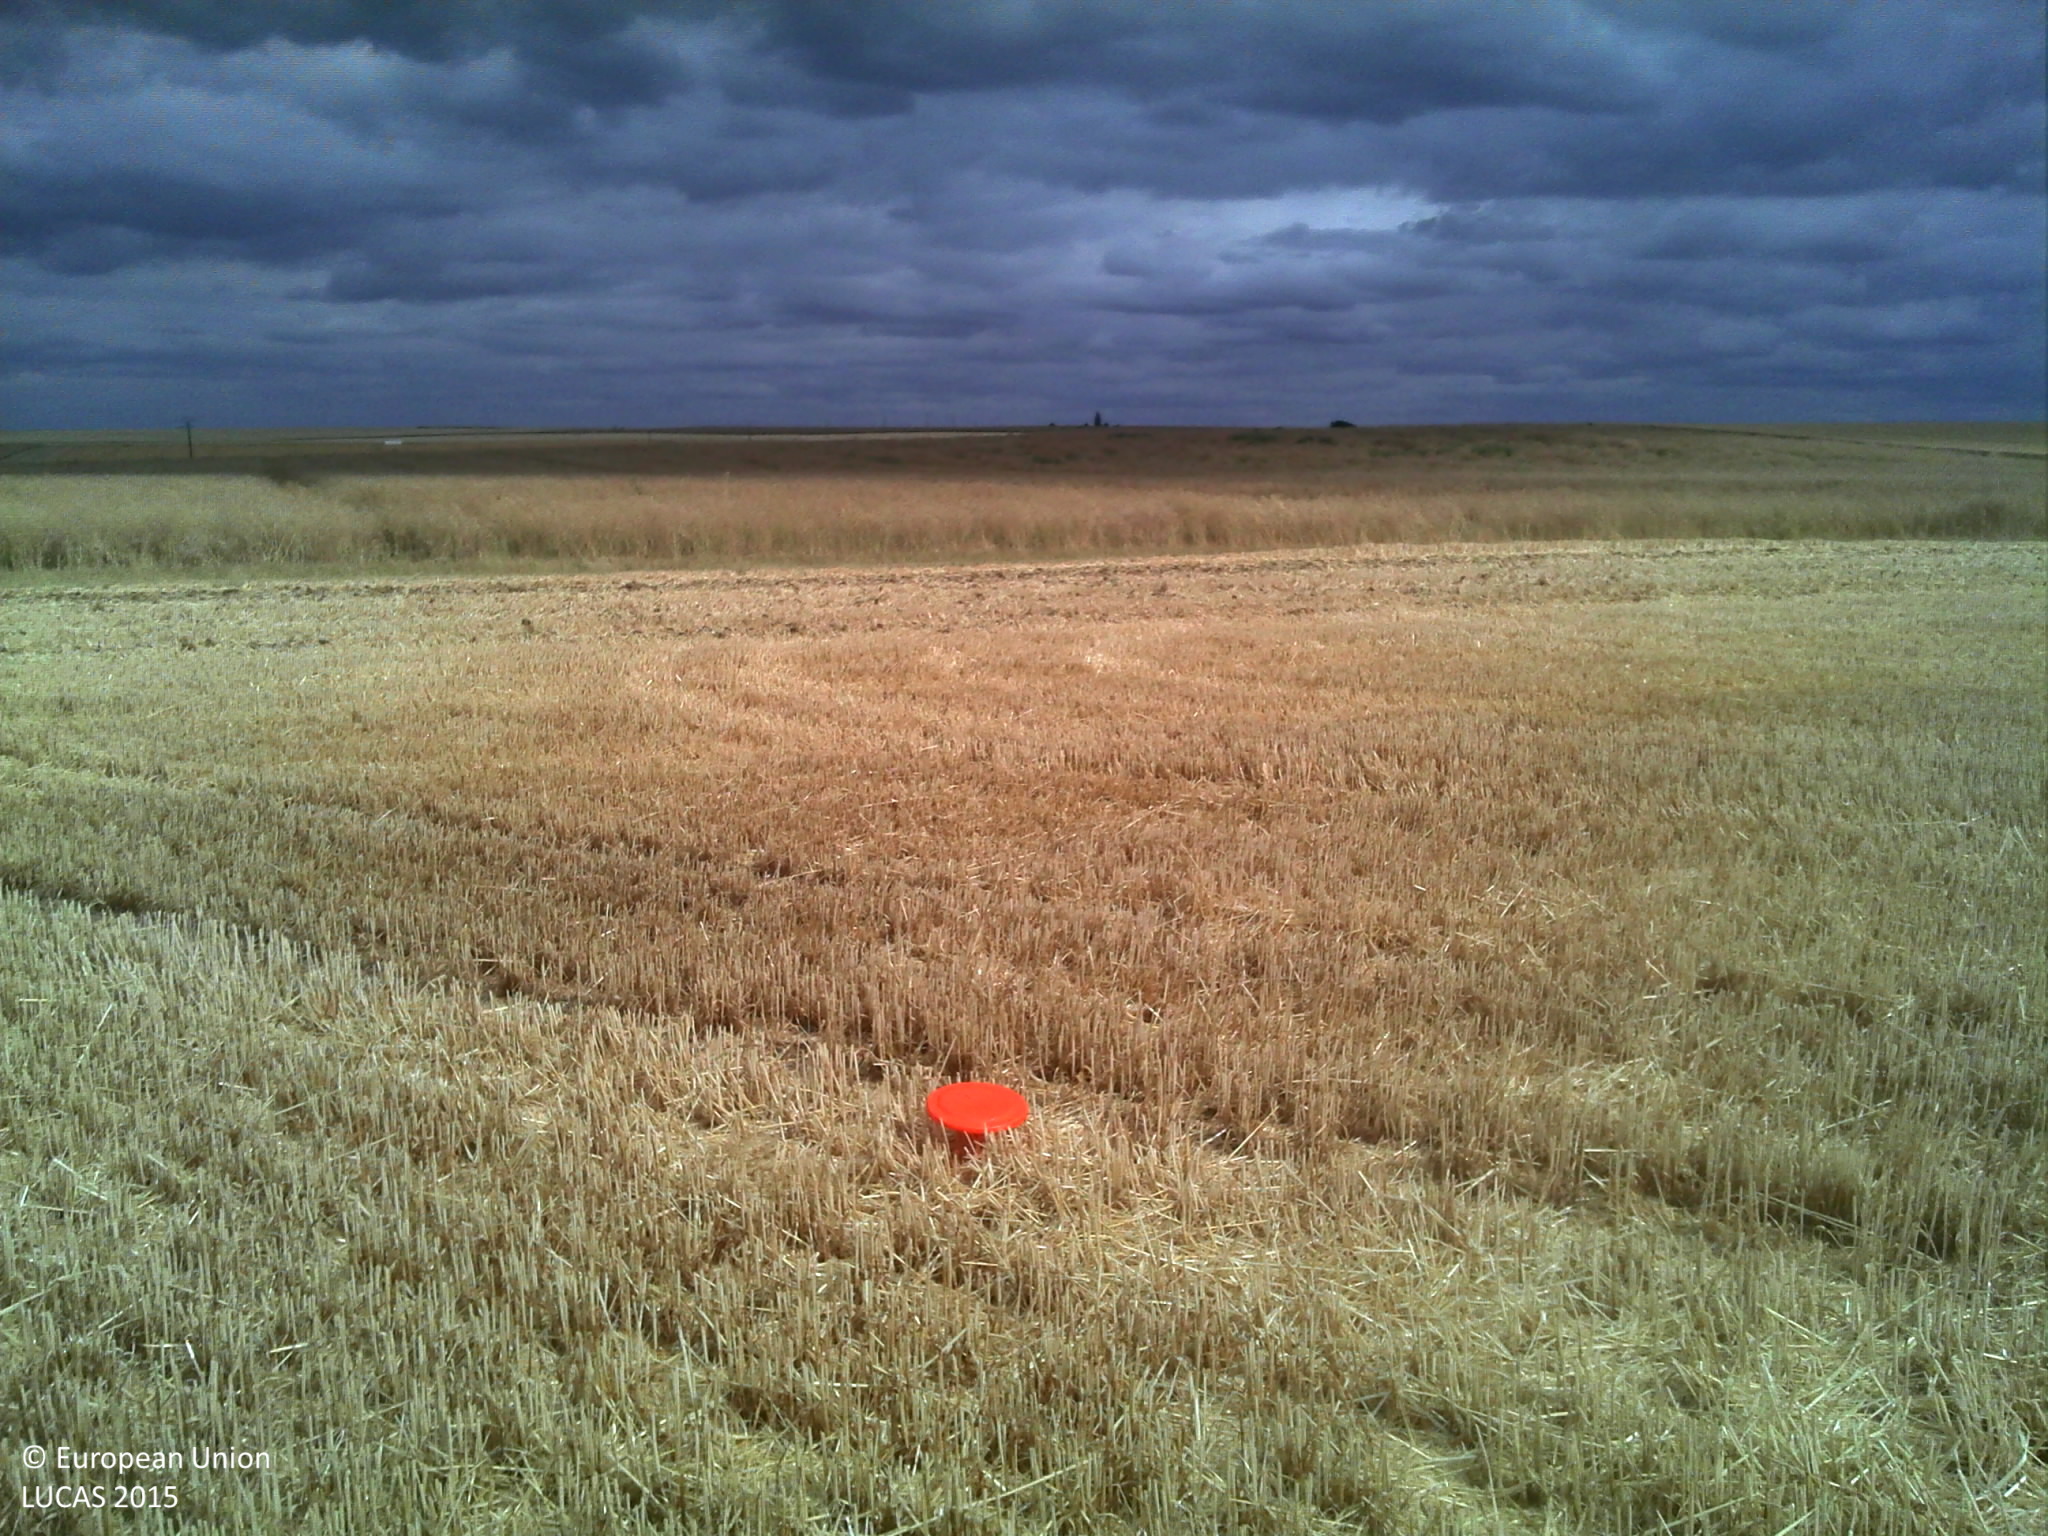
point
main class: Cropland
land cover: Common wheat
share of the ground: > 75 %
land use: Agriculture (excluding fallow land and kitchen gardens)
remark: Harvested field
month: July
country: FR
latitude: 48.3667
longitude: 3.3660
